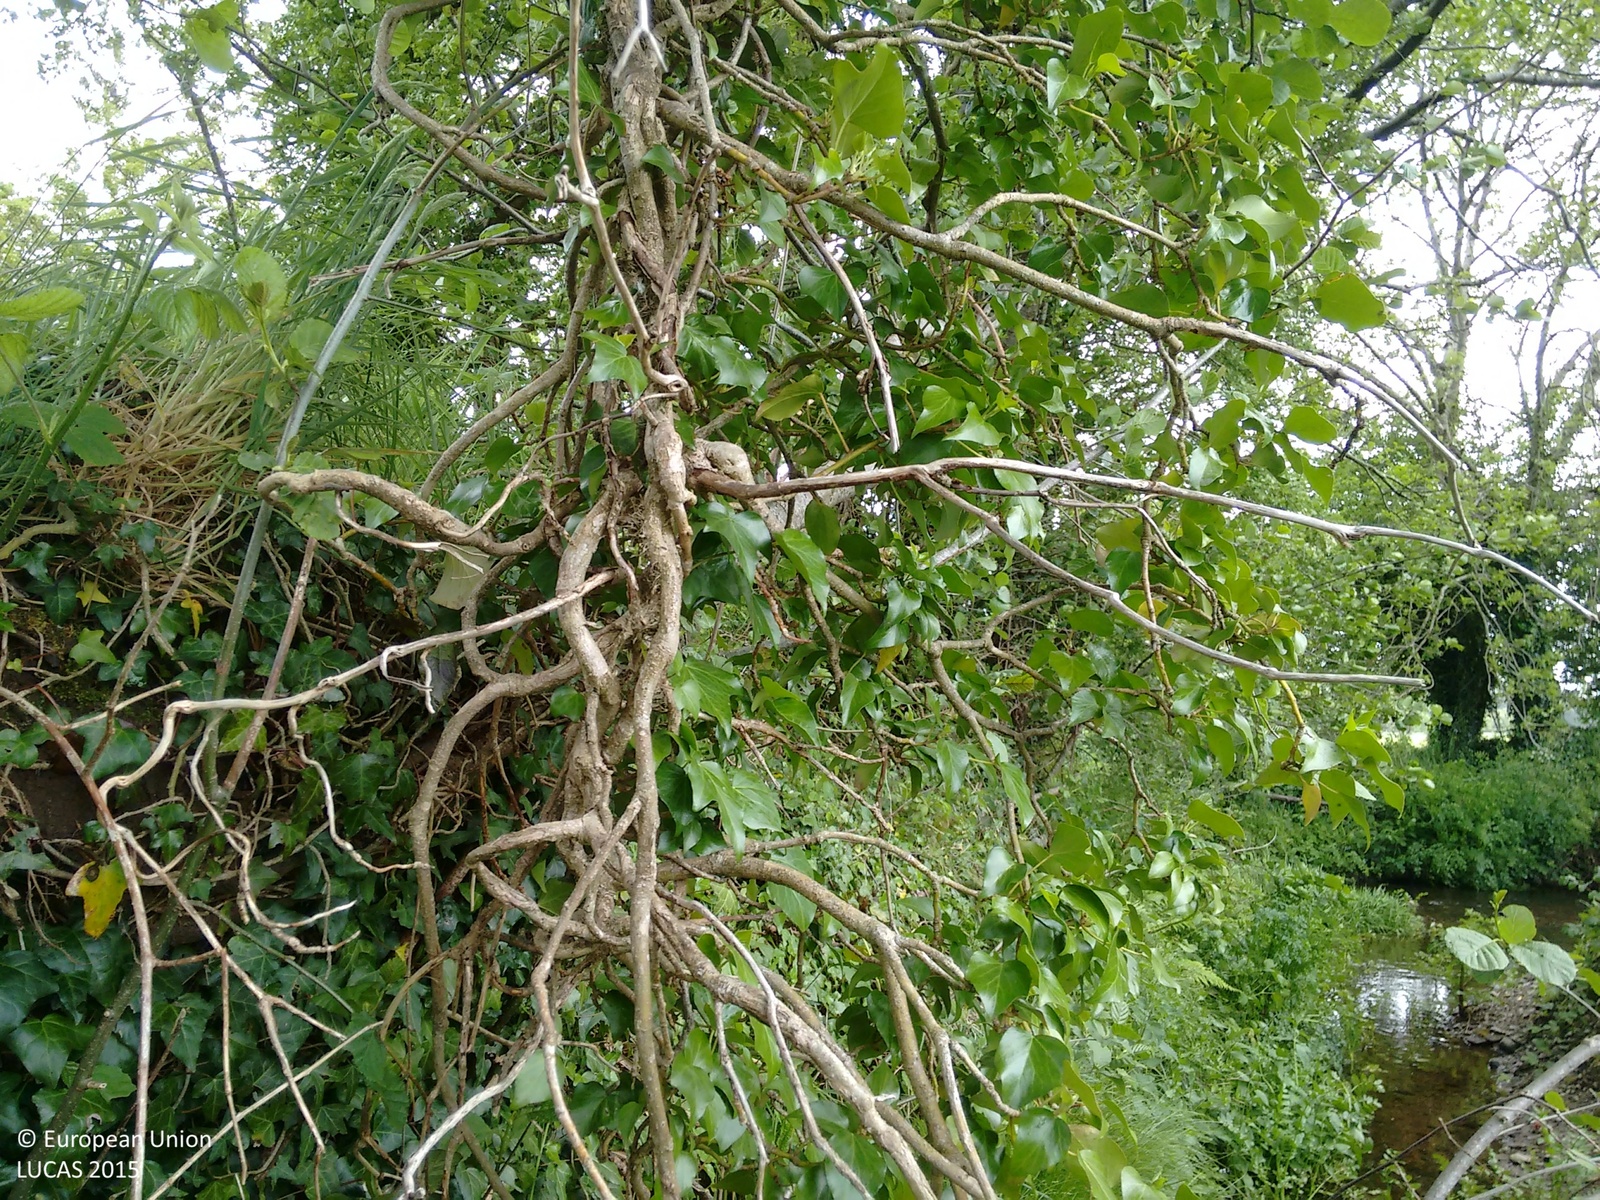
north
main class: Woodland
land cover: Broadleaved woodland
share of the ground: > 75 %
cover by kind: herbaceous plants 55 %, broadleaved forest trees 35 %
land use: Agriculture (excluding fallow land and kitchen gardens)
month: June
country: IE
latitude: 51.8483
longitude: -8.8313
